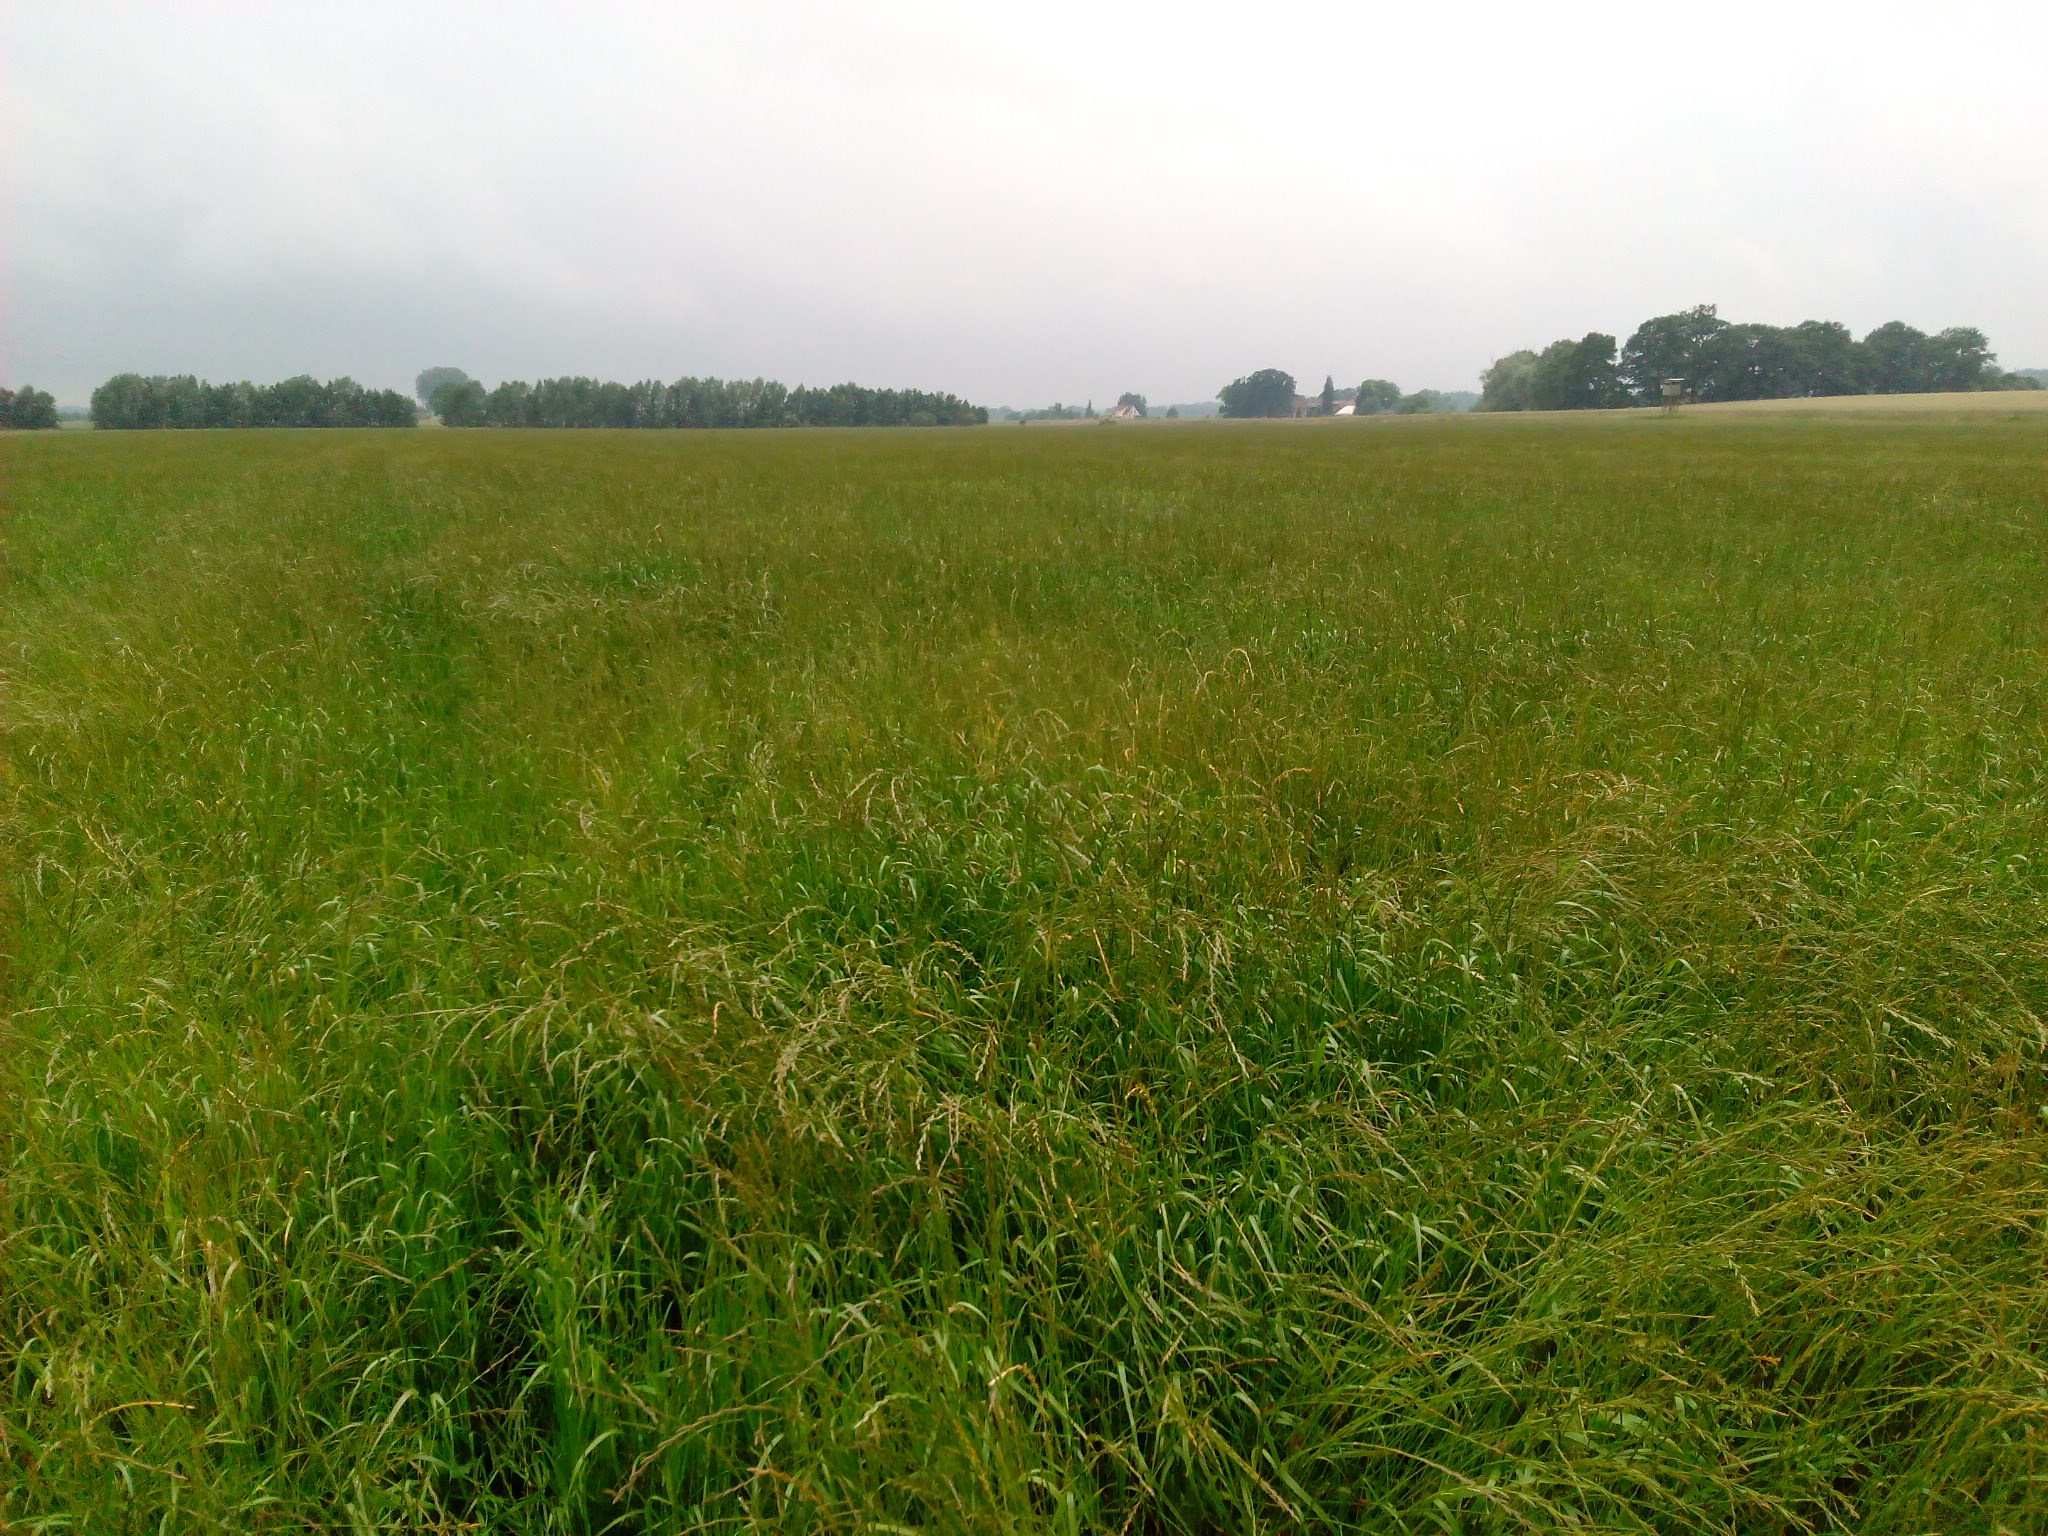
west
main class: Cropland
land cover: Temporary grasslands
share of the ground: > 75 %
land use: Agriculture (excluding fallow land and kitchen gardens)
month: June
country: DE
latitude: 53.0365
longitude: 13.1763
